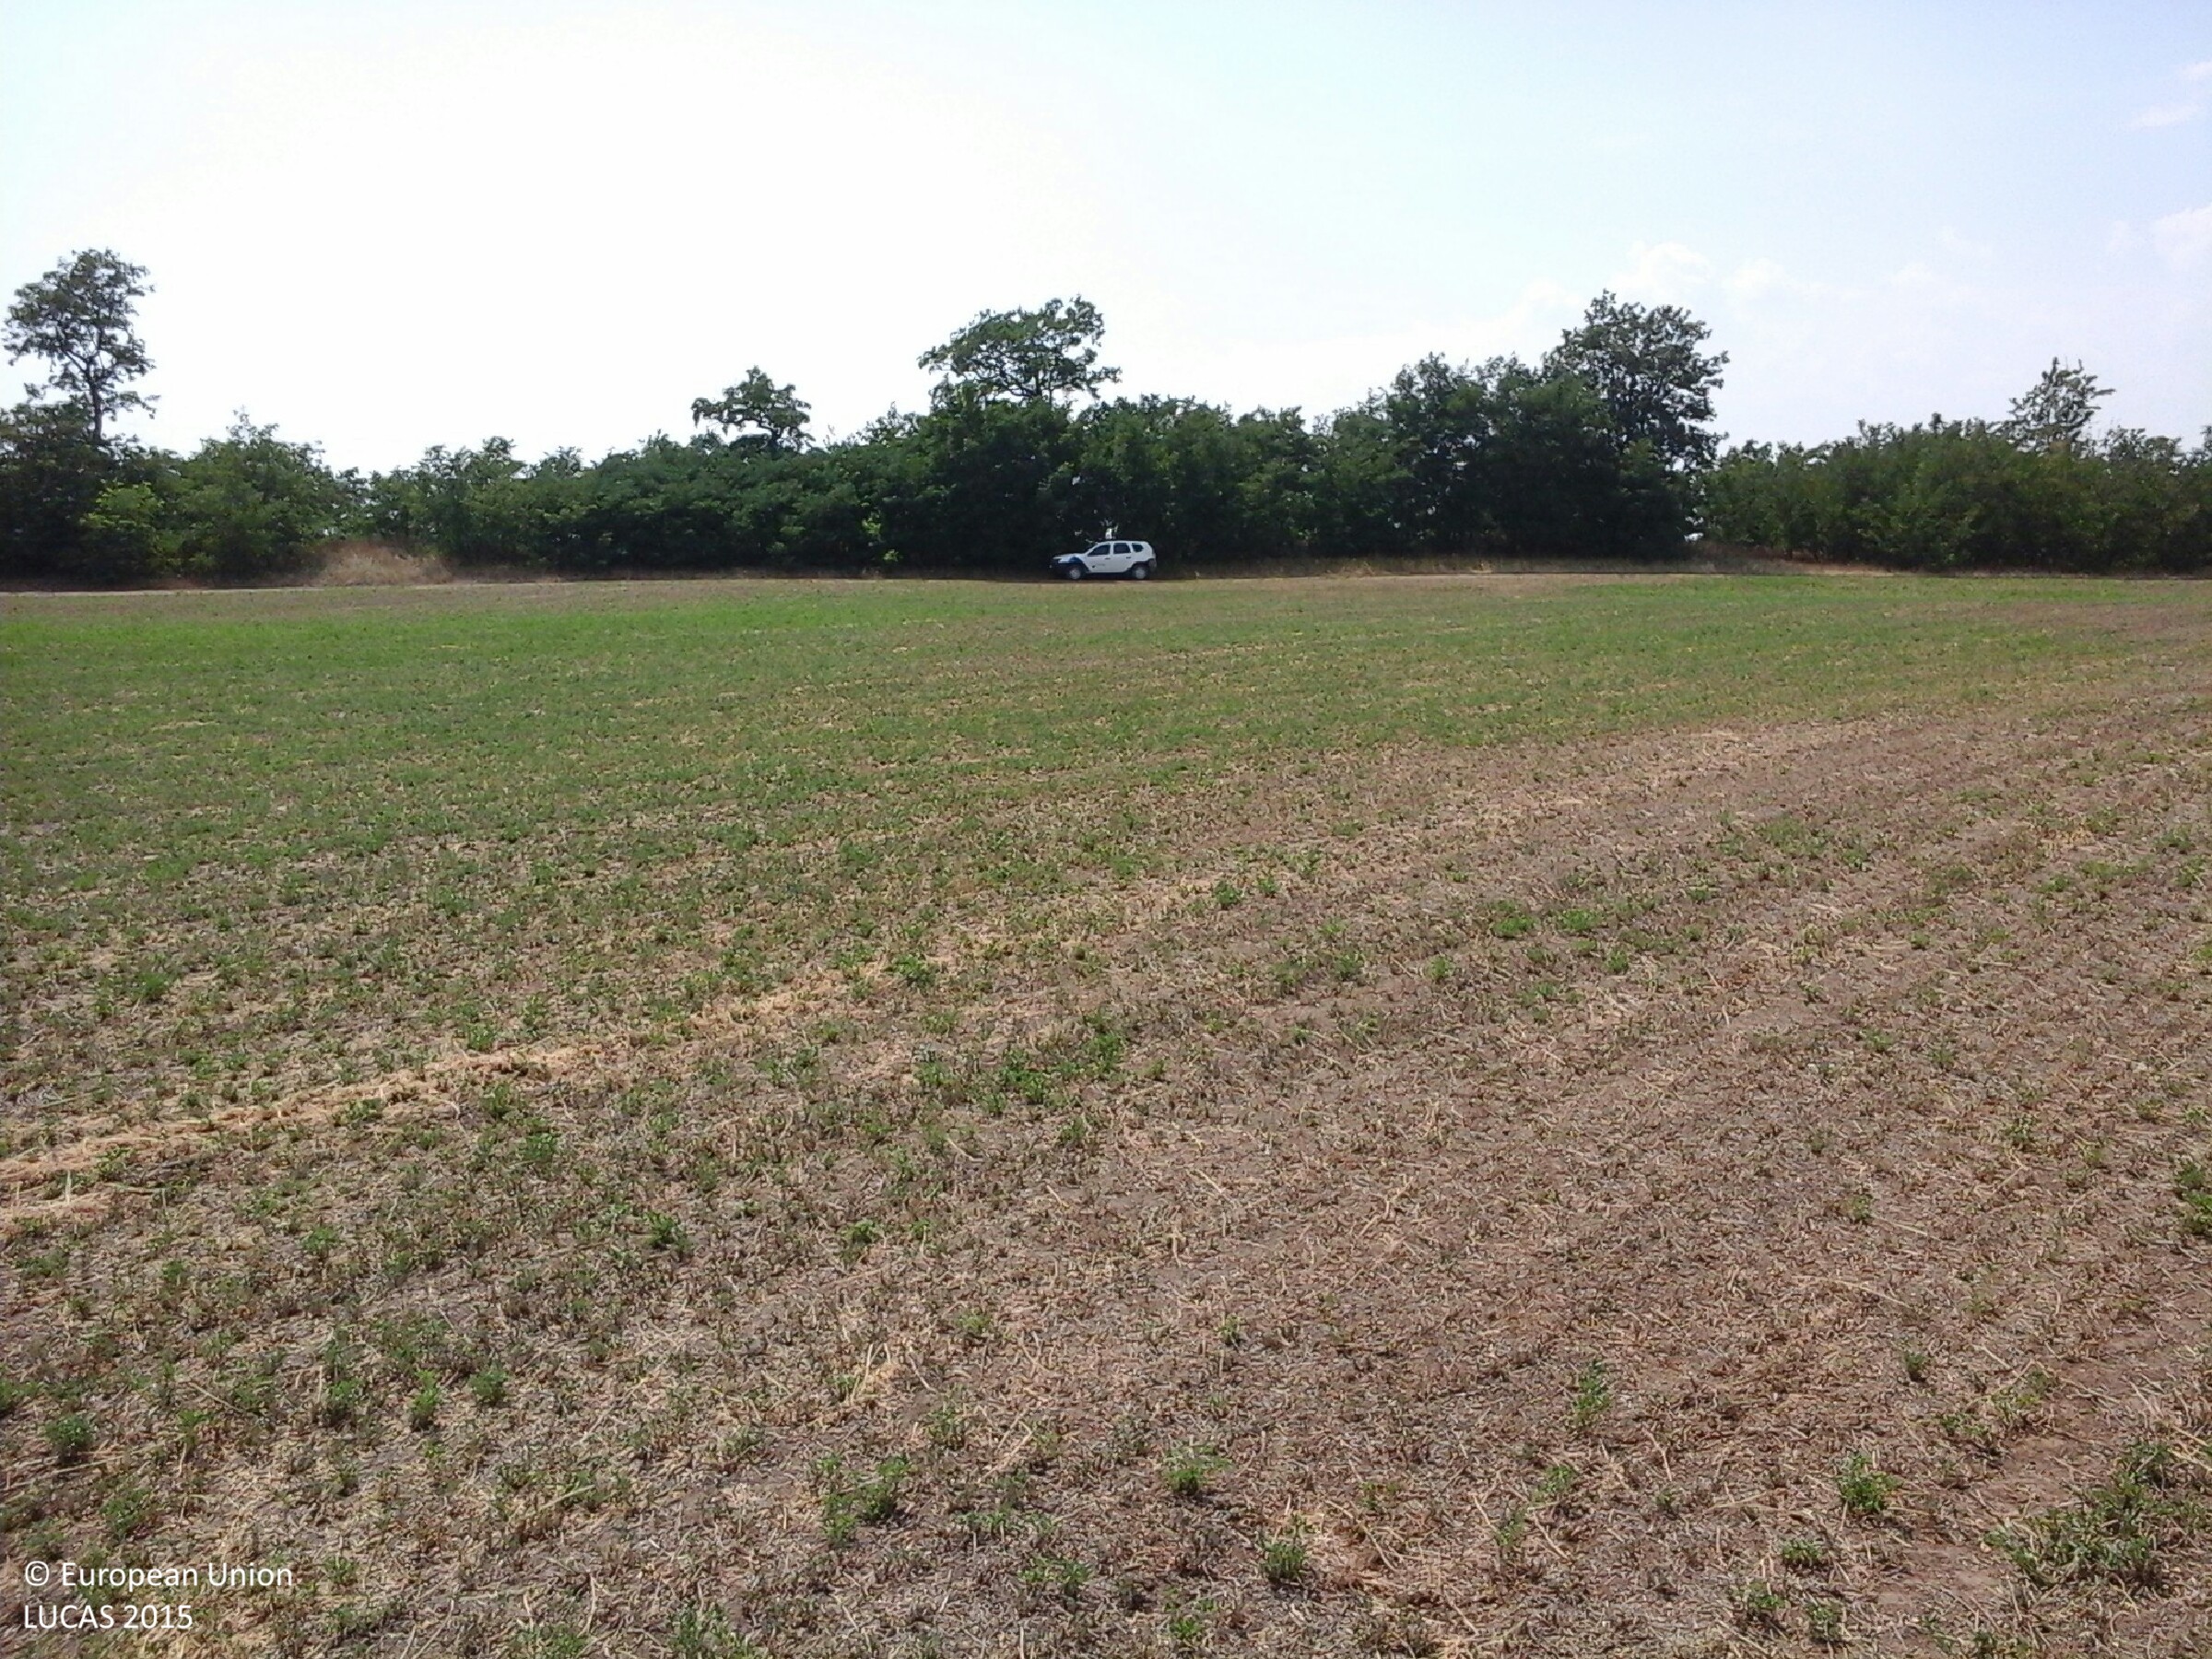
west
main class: Cropland
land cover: Lucerne
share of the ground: 50 - 75 %
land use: Agriculture (excluding fallow land and kitchen gardens)
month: July
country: HU
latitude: 47.8012
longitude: 20.9725
